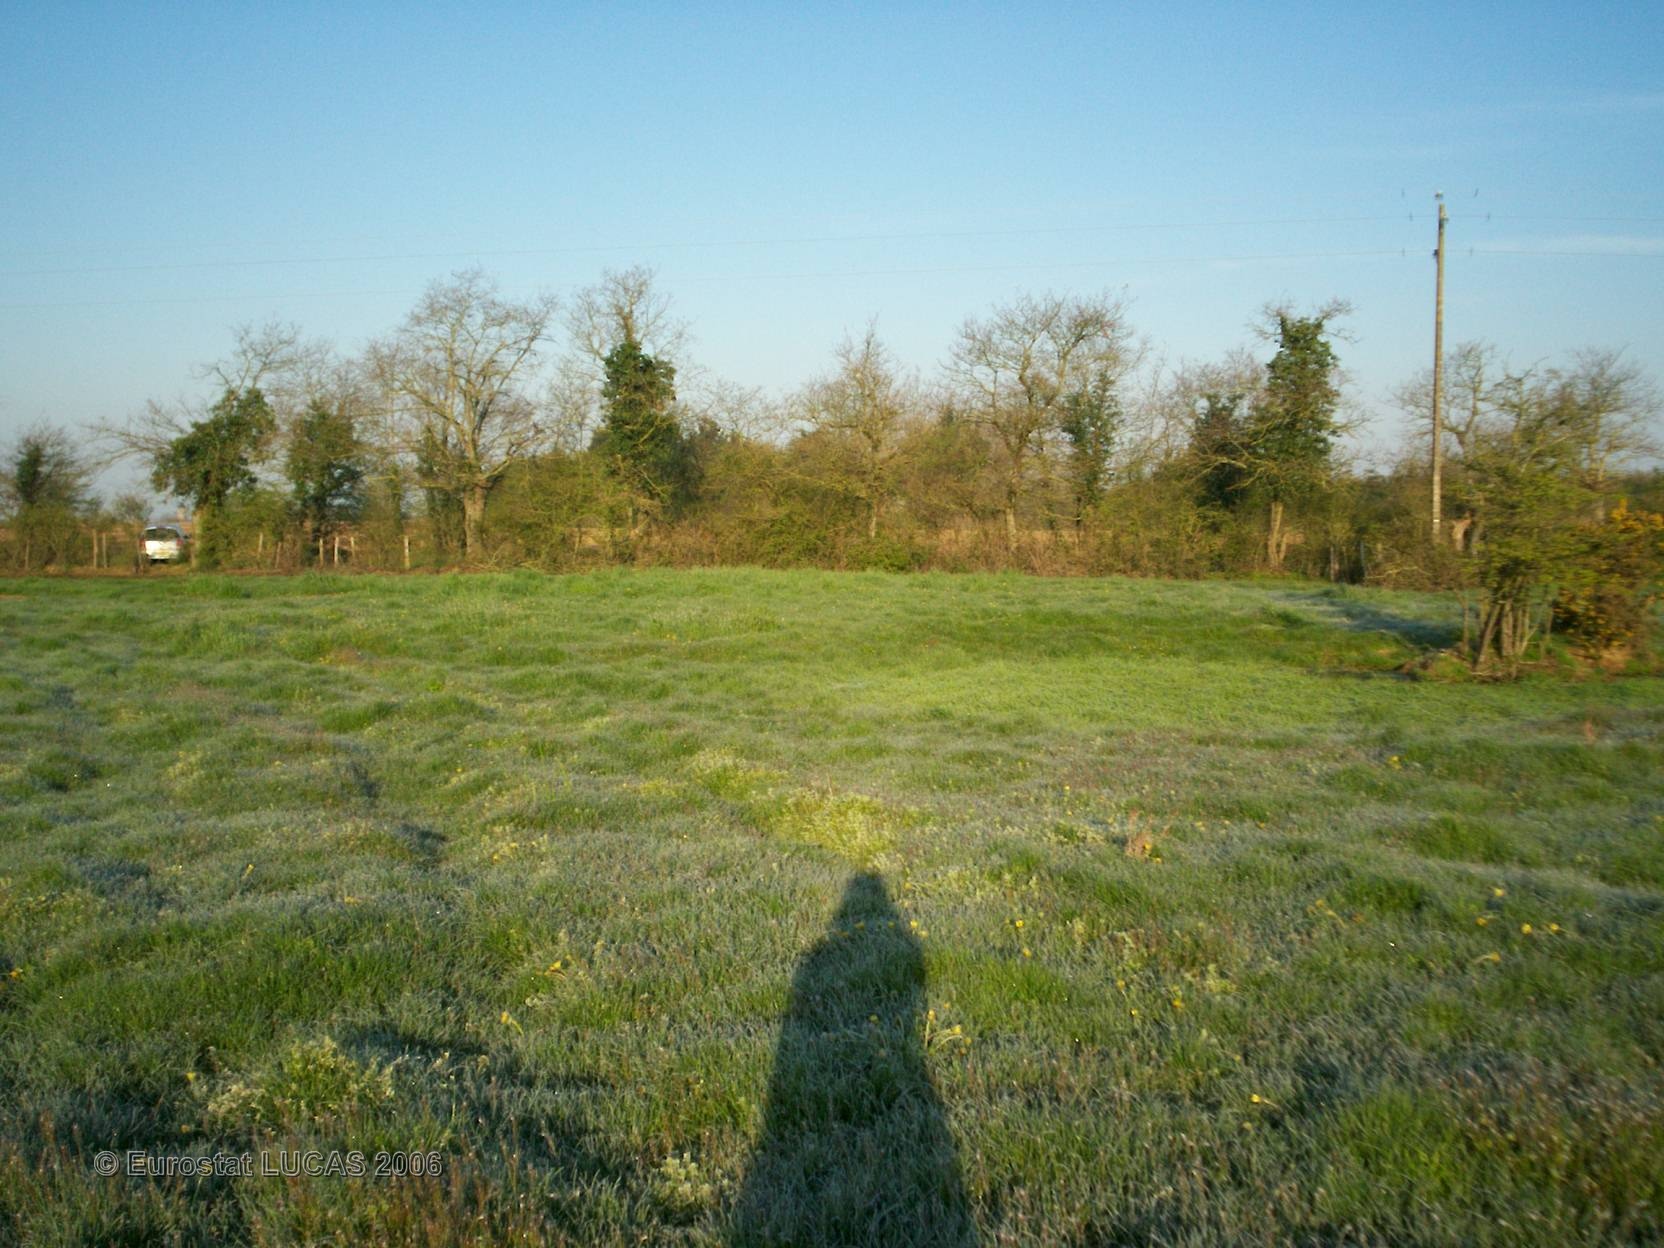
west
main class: Grassland
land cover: Grassland without tree/shrub cover
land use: Agriculture (excluding fallow land and kitchen gardens)
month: April
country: FR
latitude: 47.0418
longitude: -1.2910
